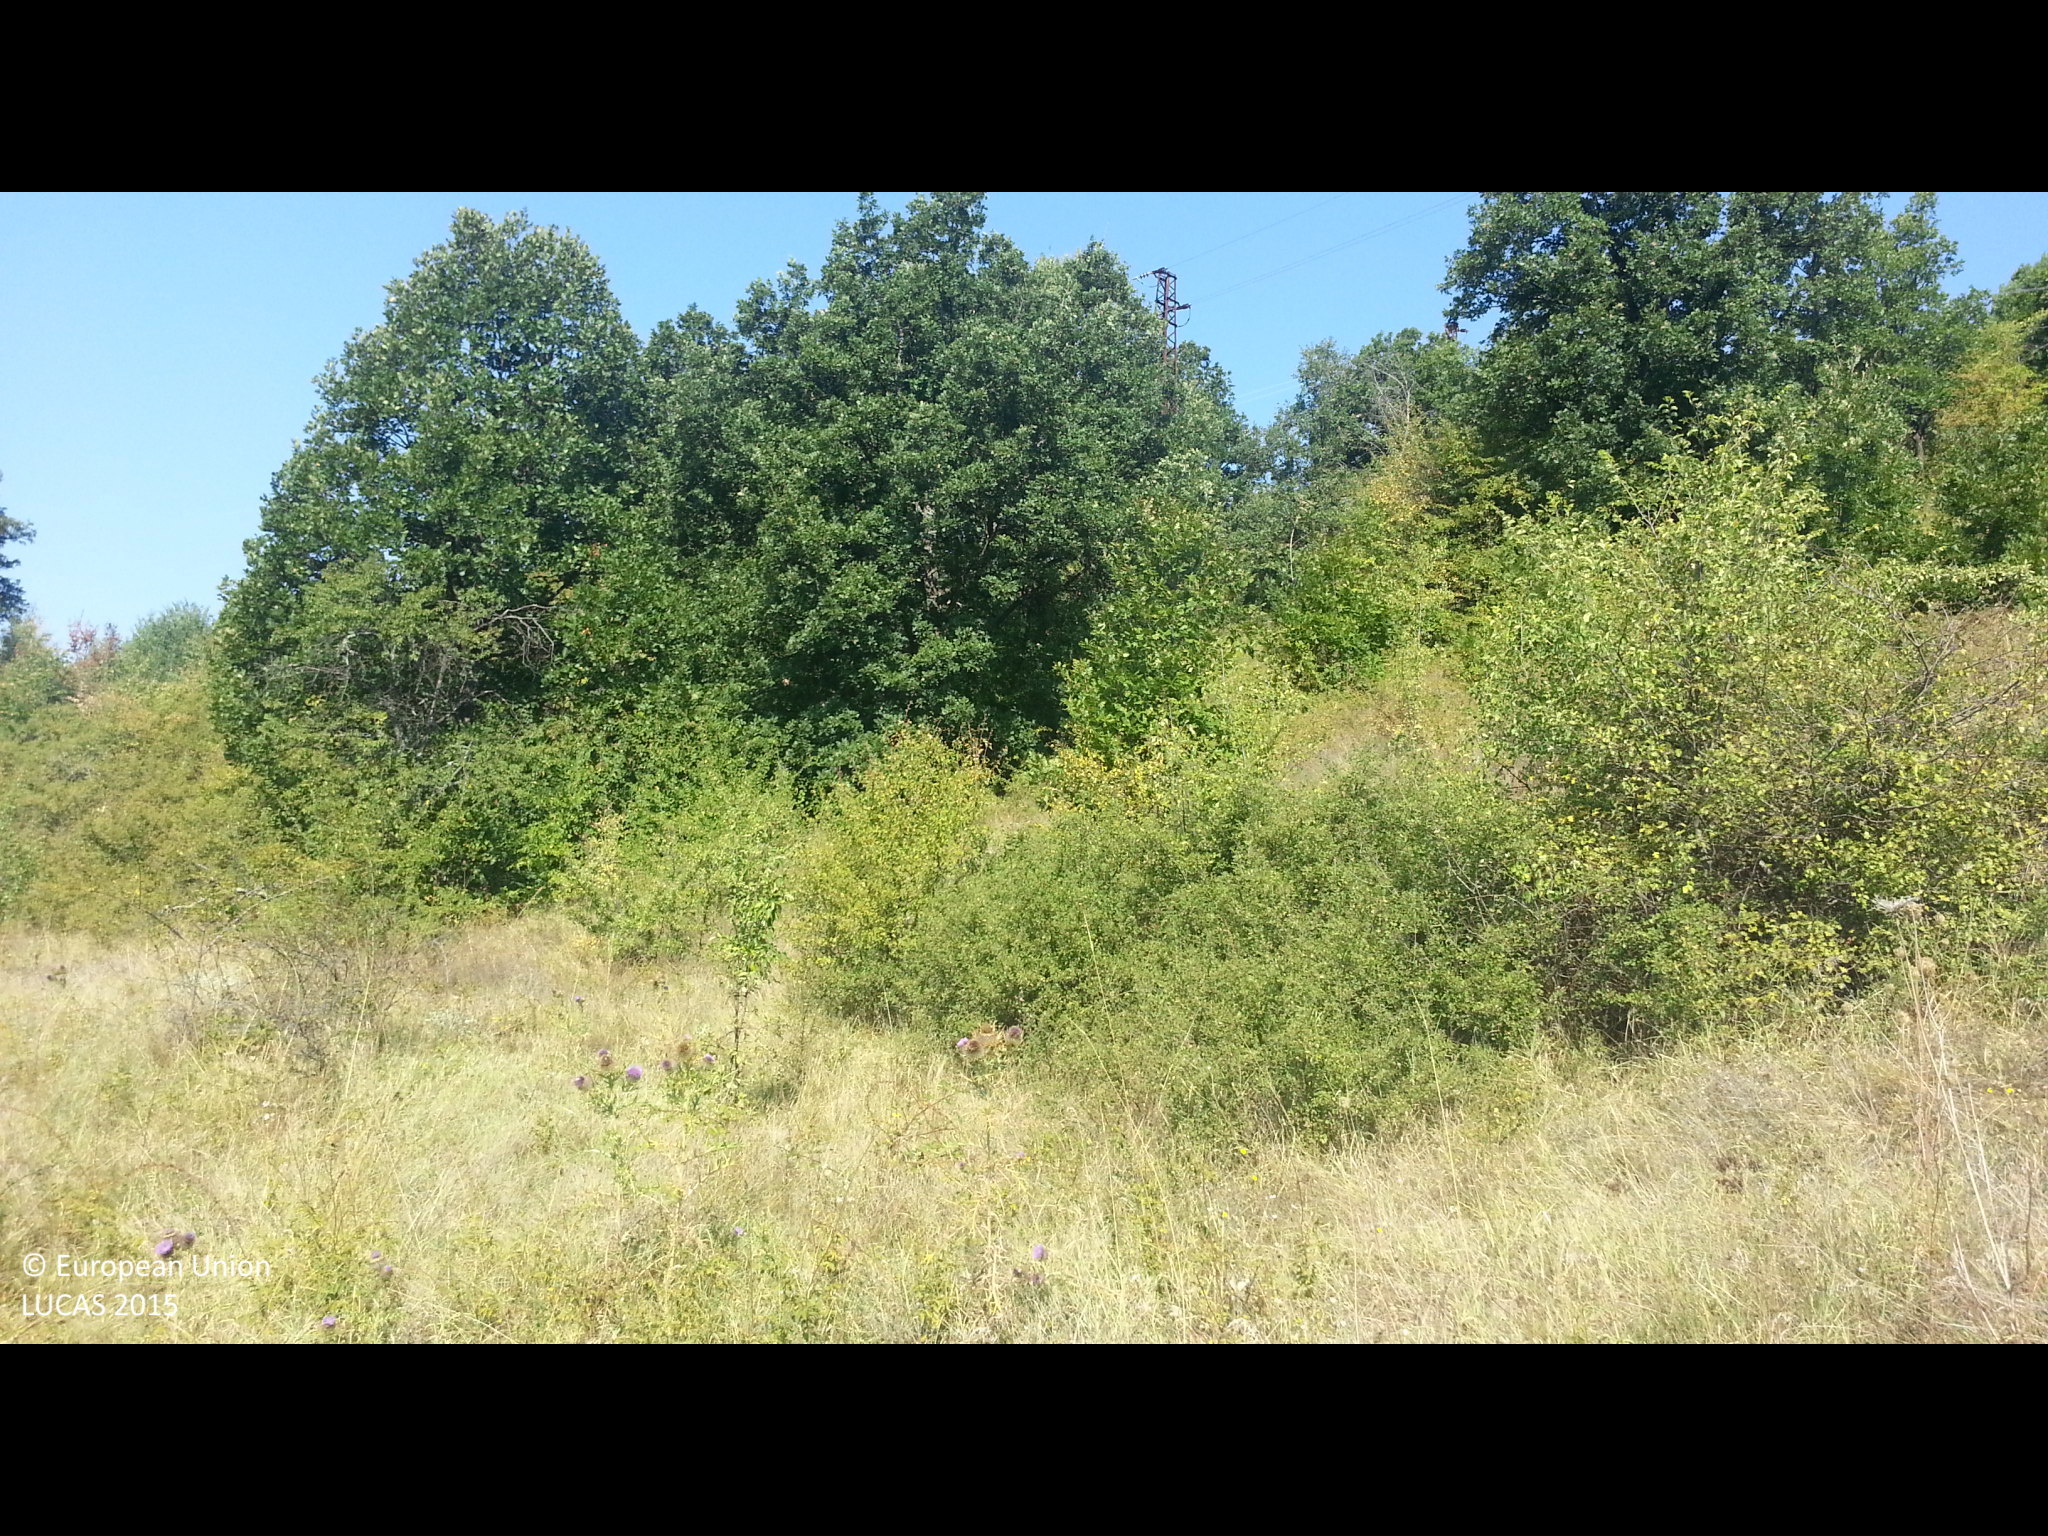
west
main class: Grassland
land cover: Grassland with sparse tree/shrub cover
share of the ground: > 75 %
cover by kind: herbaceous plants 95 %, broadleaved forest trees 5 %
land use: Semi-natural and natural areas not in use
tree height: < 5 m
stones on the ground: < 10 %
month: September
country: BG
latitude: 42.3805
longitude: 22.9856
